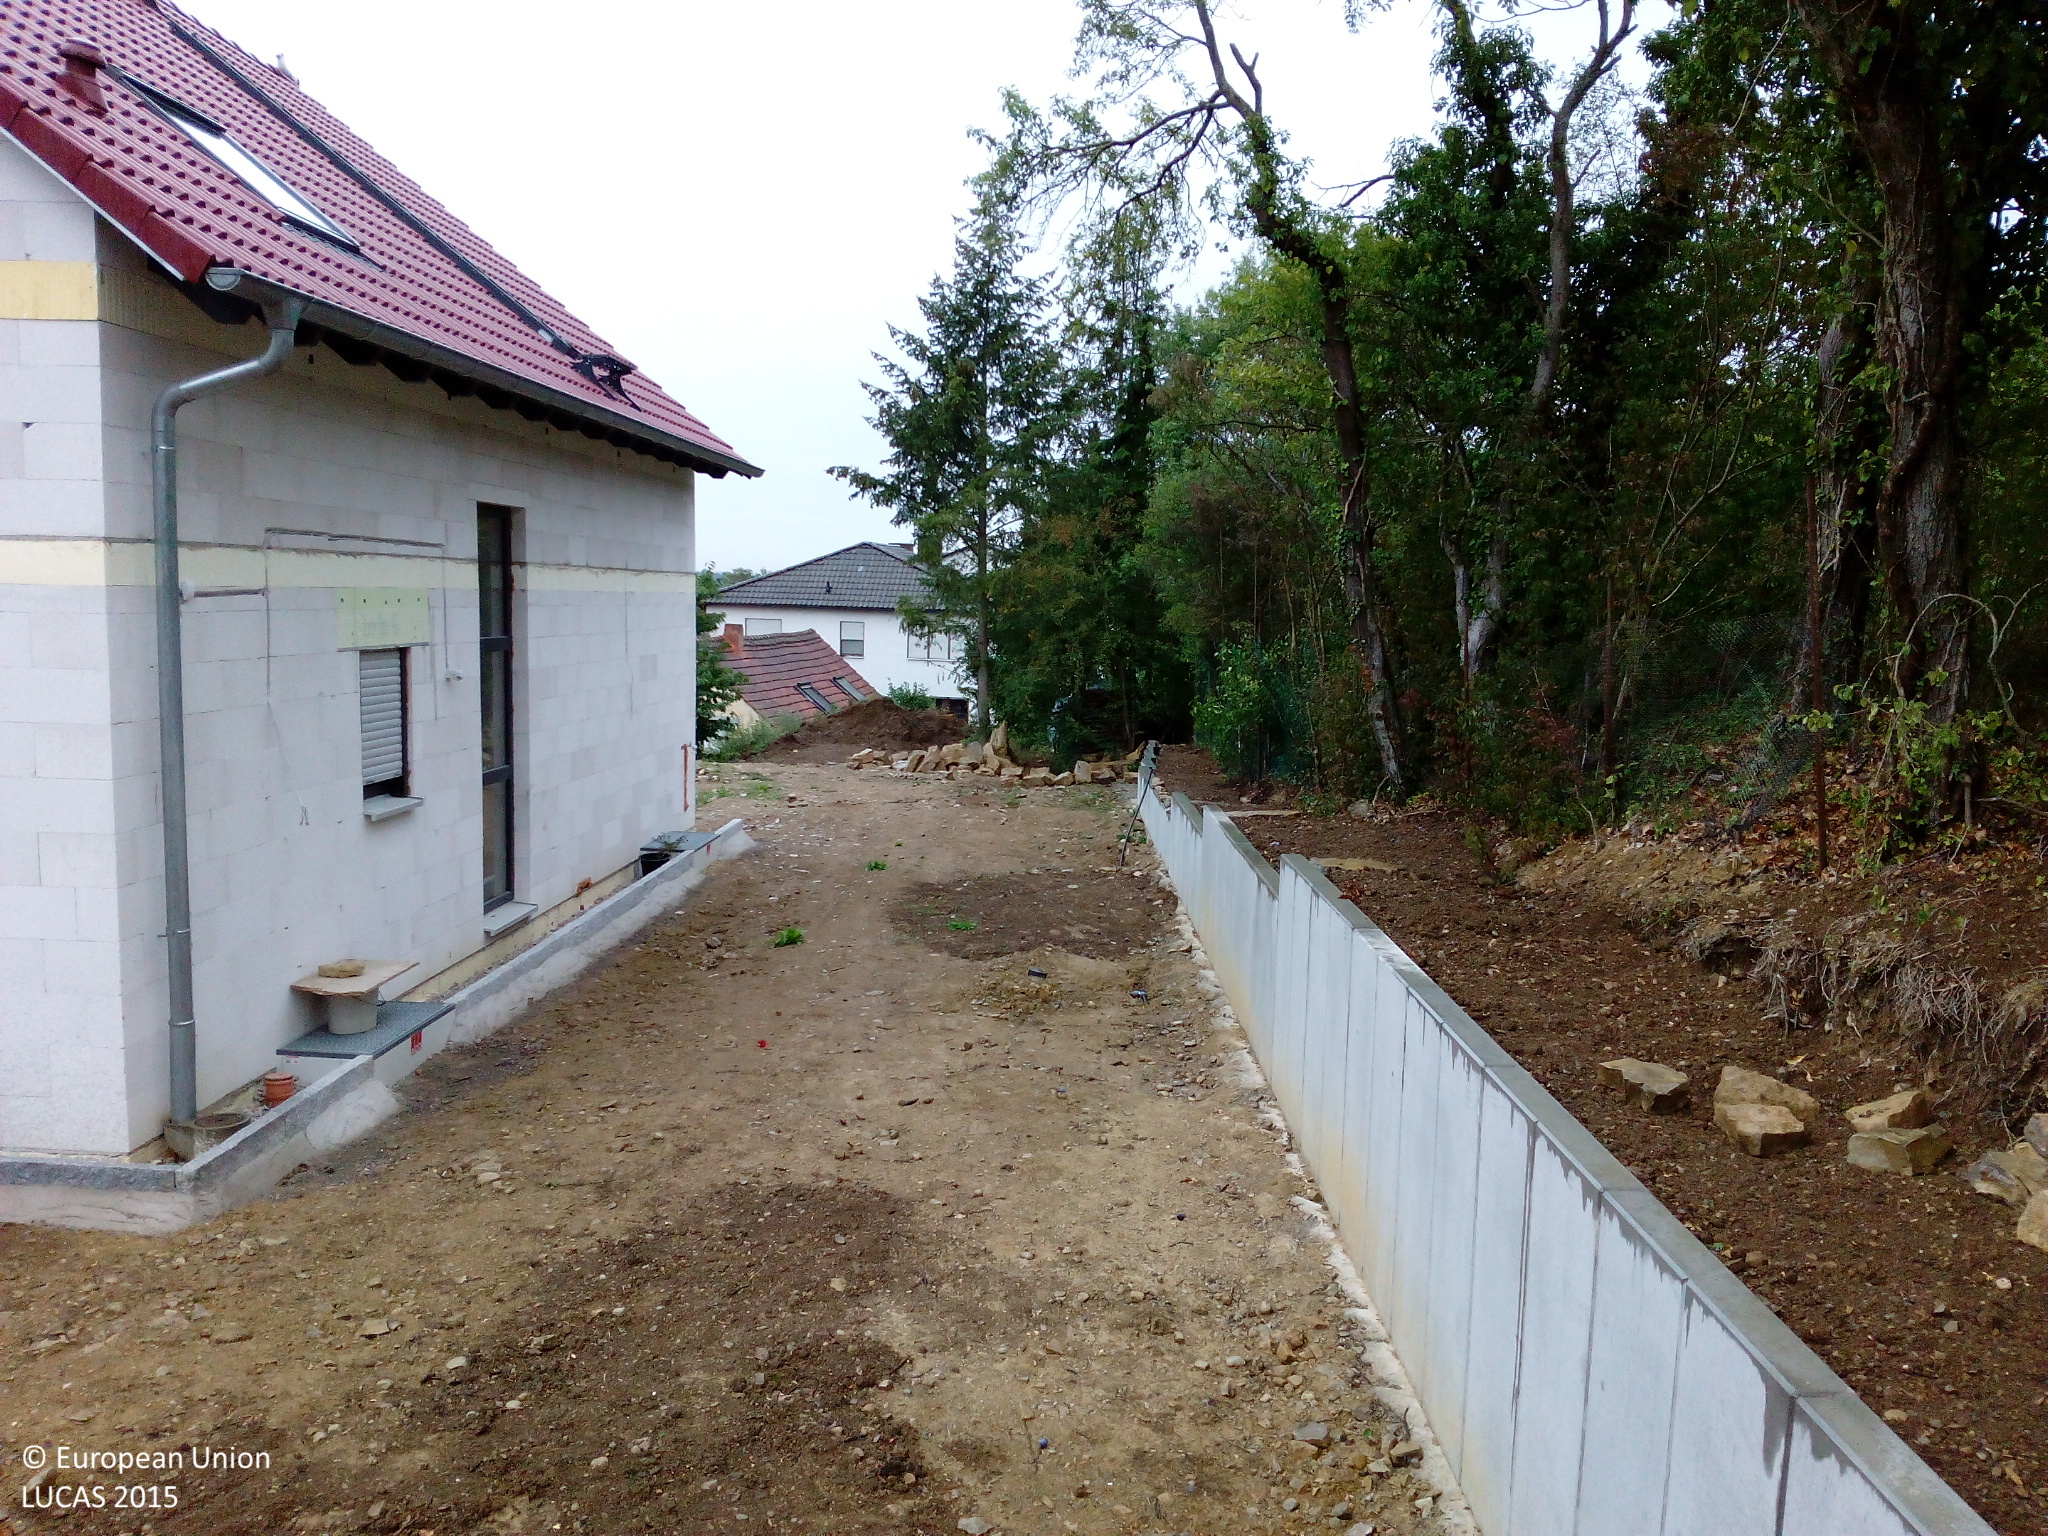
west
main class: Shrubland
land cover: Shrubland with sparse tree cover
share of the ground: > 75 %
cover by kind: shrubs 95 %, broadleaved forest trees 5 %
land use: Residential
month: September
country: DE
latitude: 49.8245
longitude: 9.9305
